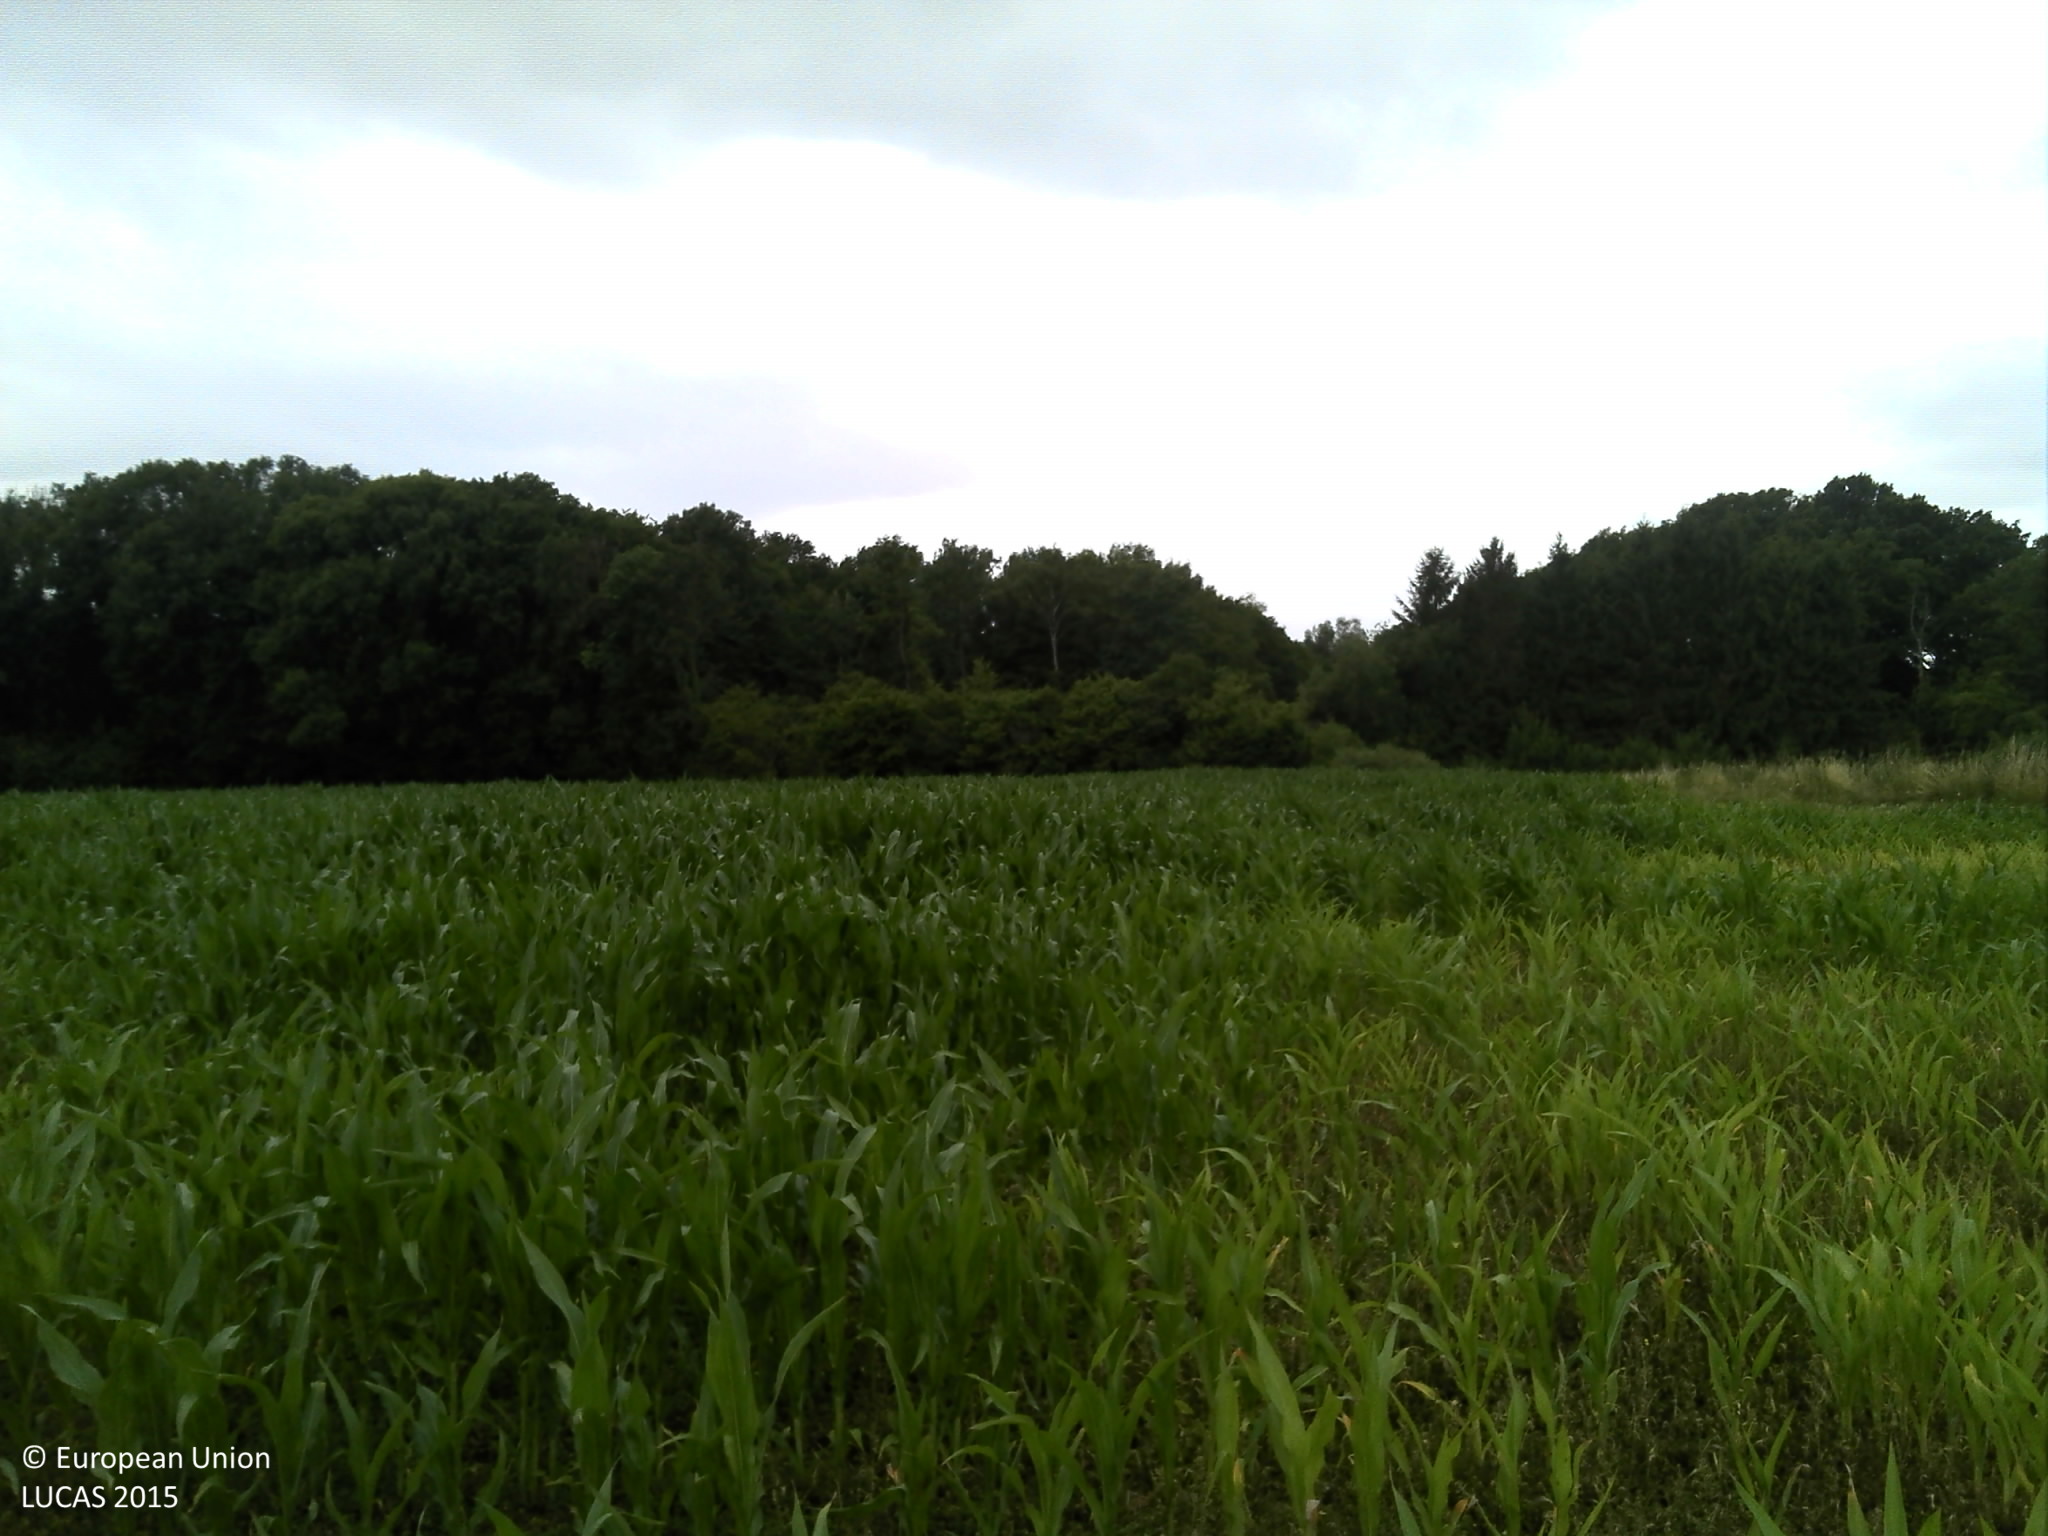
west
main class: Cropland
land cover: Maize
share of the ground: 25 - 50 %
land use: Agriculture (excluding fallow land and kitchen gardens)
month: July
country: FR
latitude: 49.8036
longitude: 4.5914
